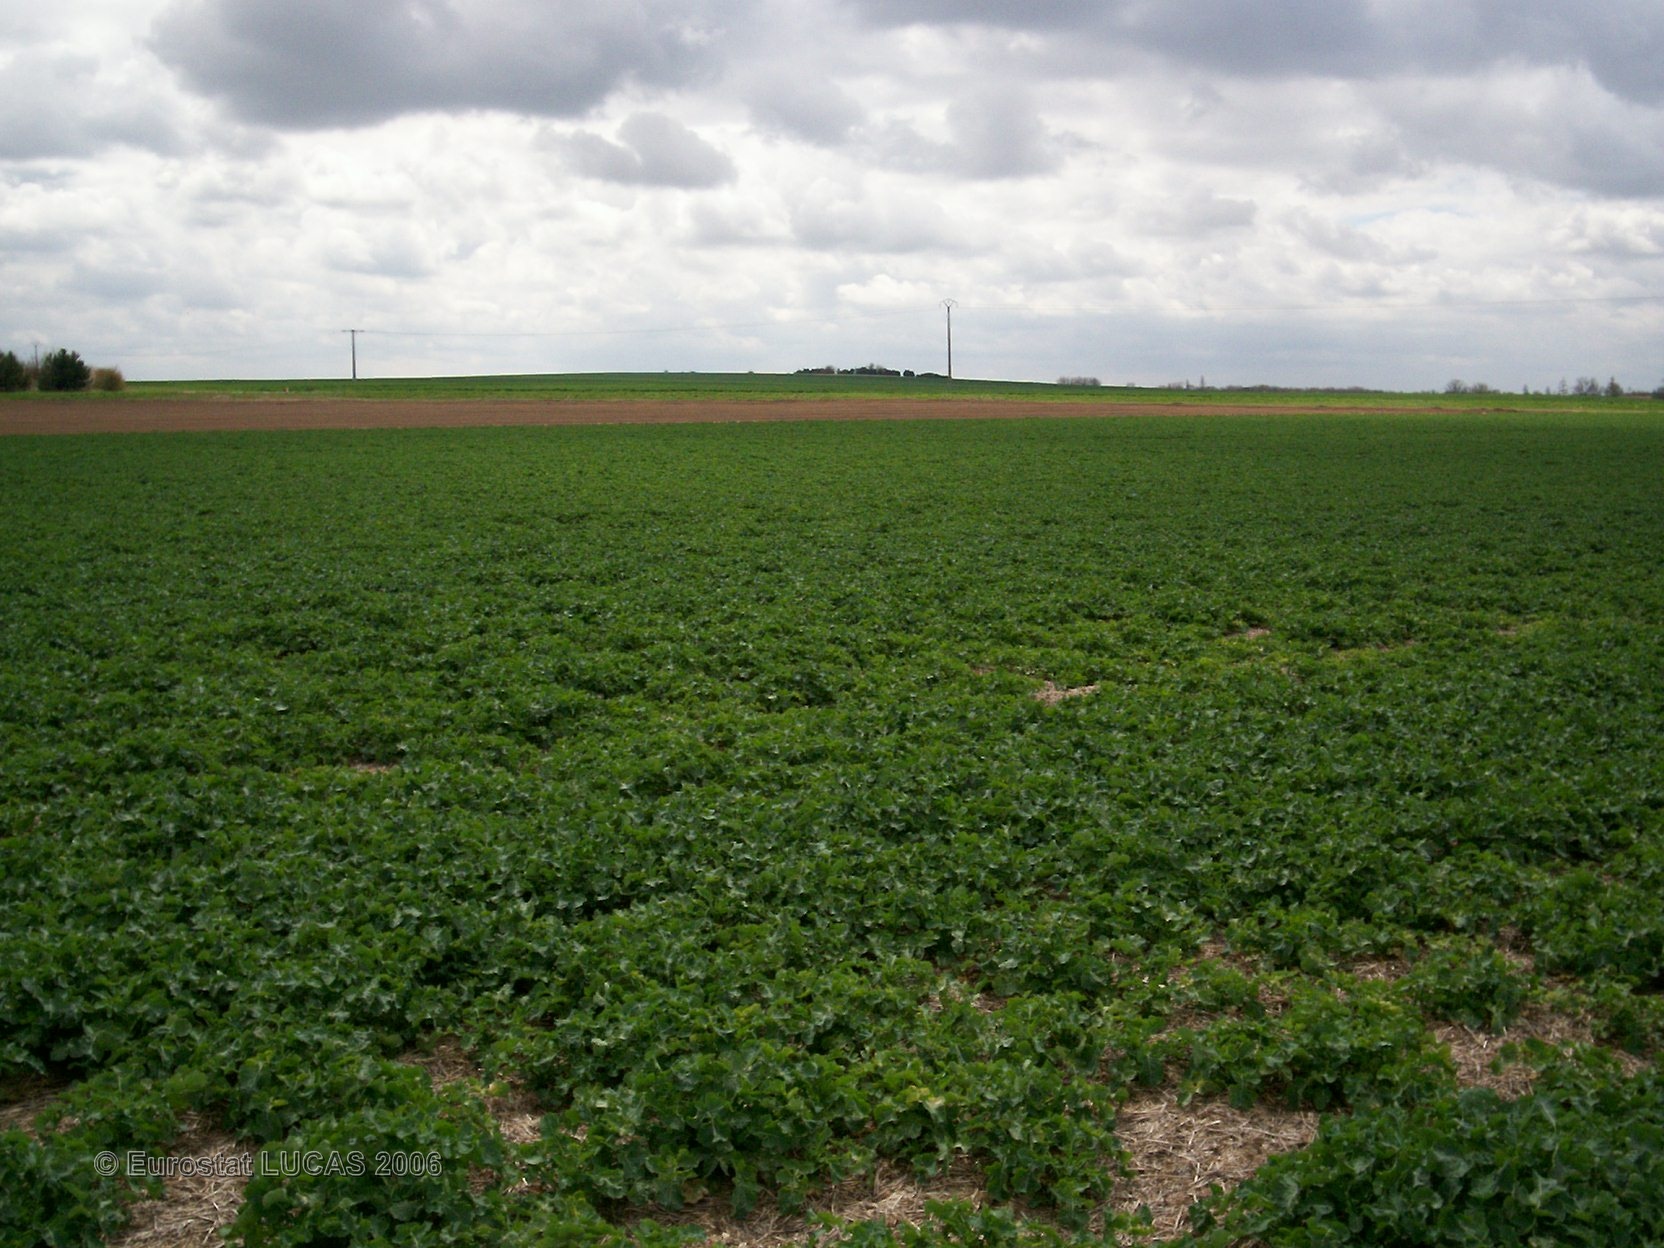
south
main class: Cropland
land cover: Rape and turnip rape
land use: Agriculture (excluding fallow land and kitchen gardens)
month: April
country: FR
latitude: 48.4723
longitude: 3.9494
